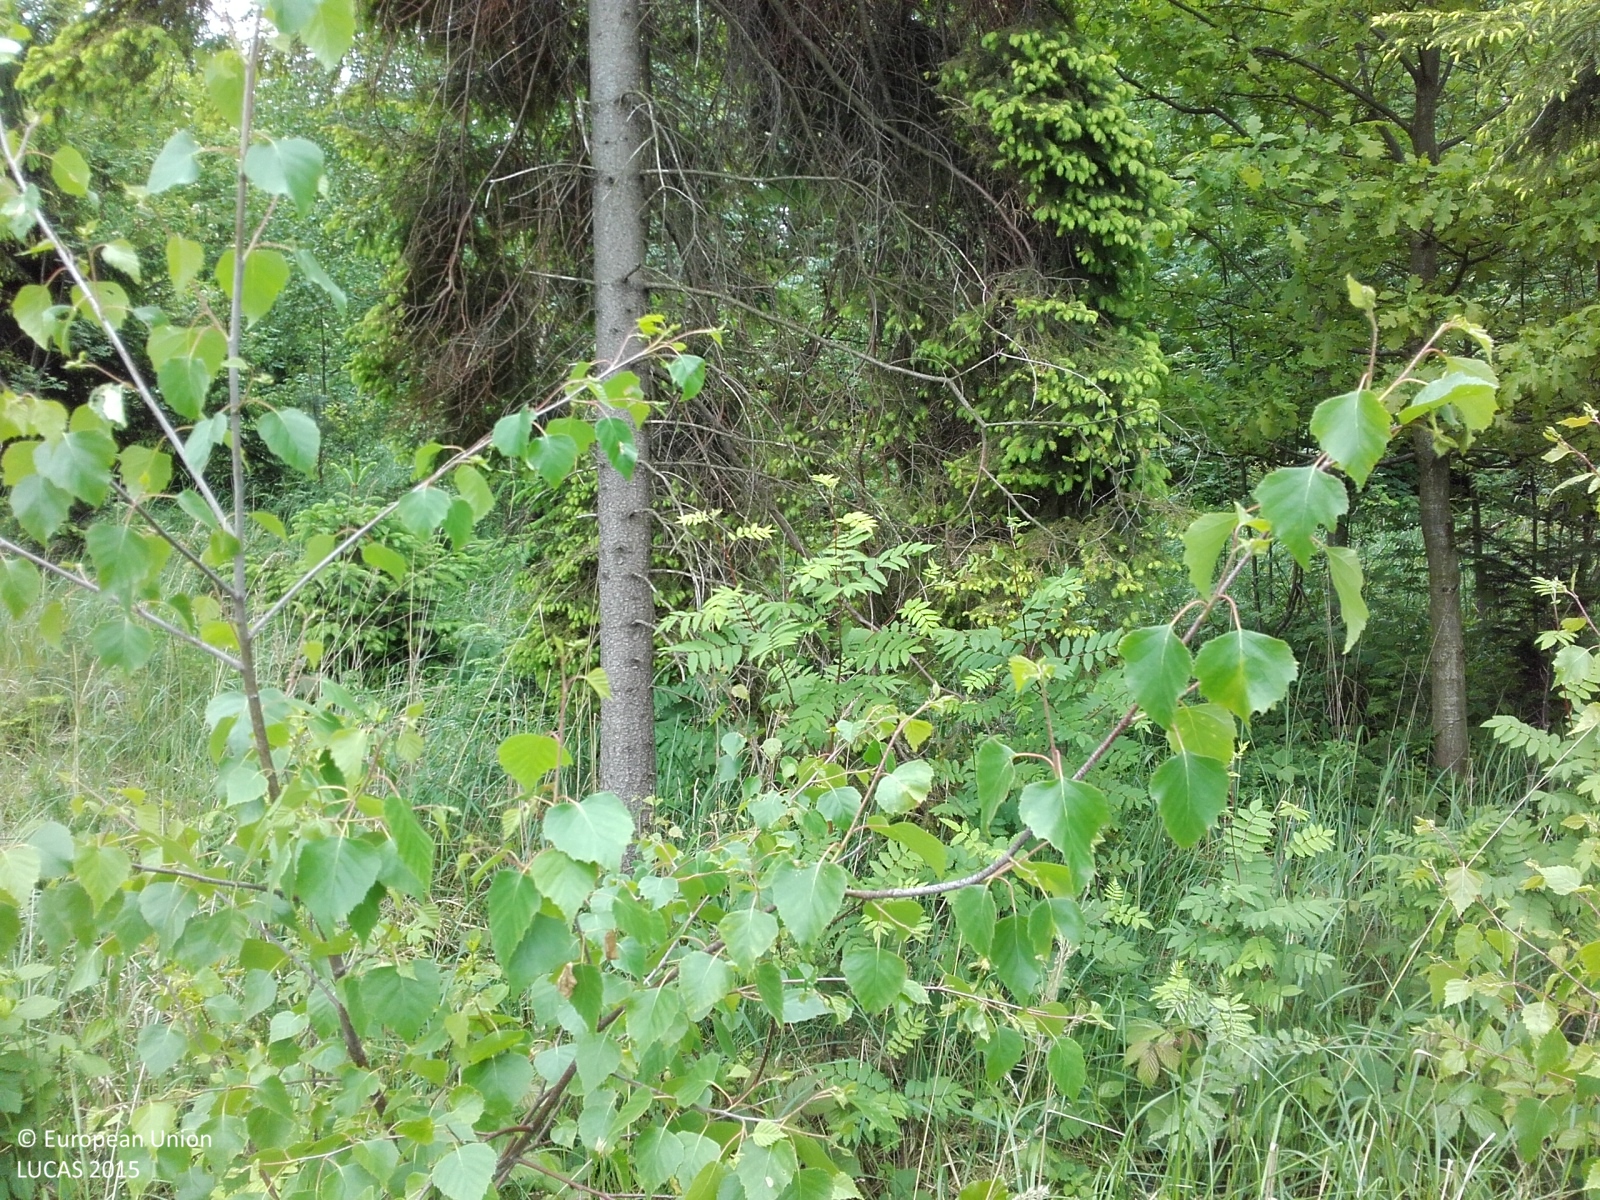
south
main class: Woodland
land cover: Spruce dominated coniferous woodland
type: hemiboreal forest and nemoral coniferous forest and mixed broadleaved-coniferous forest
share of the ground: > 75 %
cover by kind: coniferous forest trees 90 %, herbaceous plants 5 %, lichens and mosses 5 %
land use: Forestry
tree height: > 5 m
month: May
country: CZ
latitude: 49.6150
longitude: 17.7226
